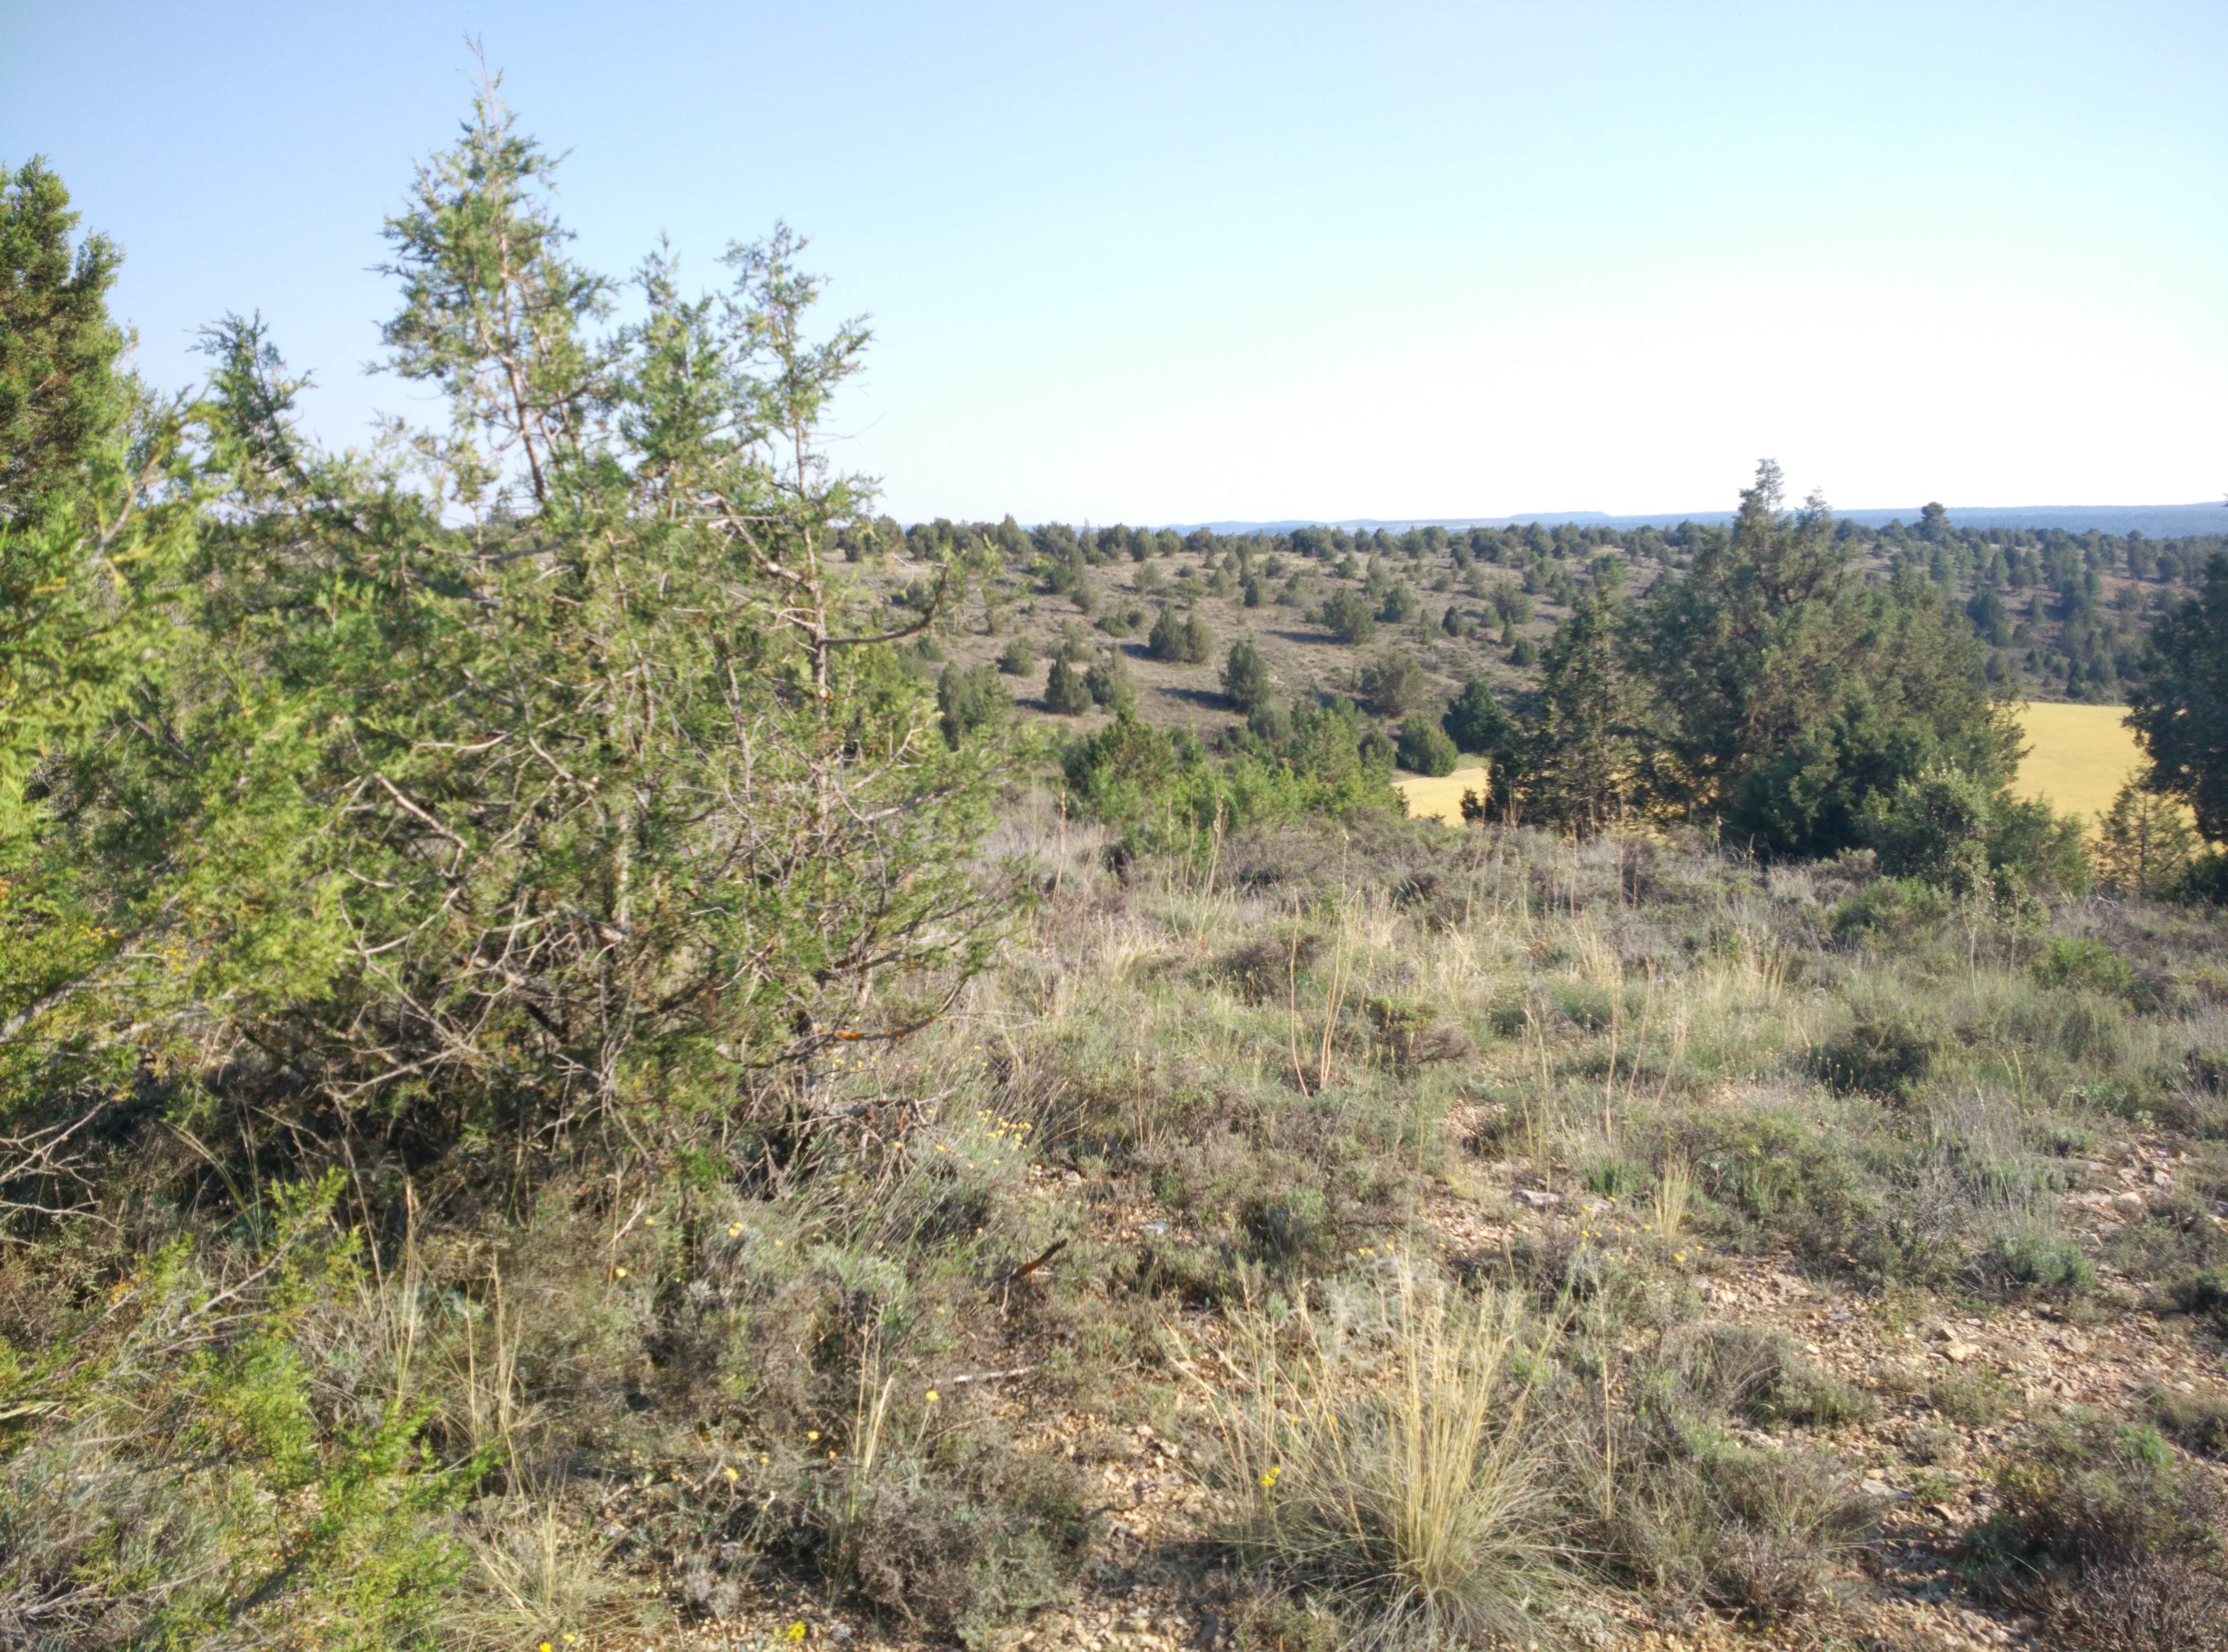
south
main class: Shrubland
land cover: Shrubland with sparse tree cover
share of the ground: 25 - 50 %
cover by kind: unconsolidated bare surface 50 %, shrubs 40 %, coniferous forest trees 5 %, herbaceous plants 5 %
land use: Semi-natural and natural areas not in use
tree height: > 5 m
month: June
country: ES
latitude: 40.7757
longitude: -1.9534
